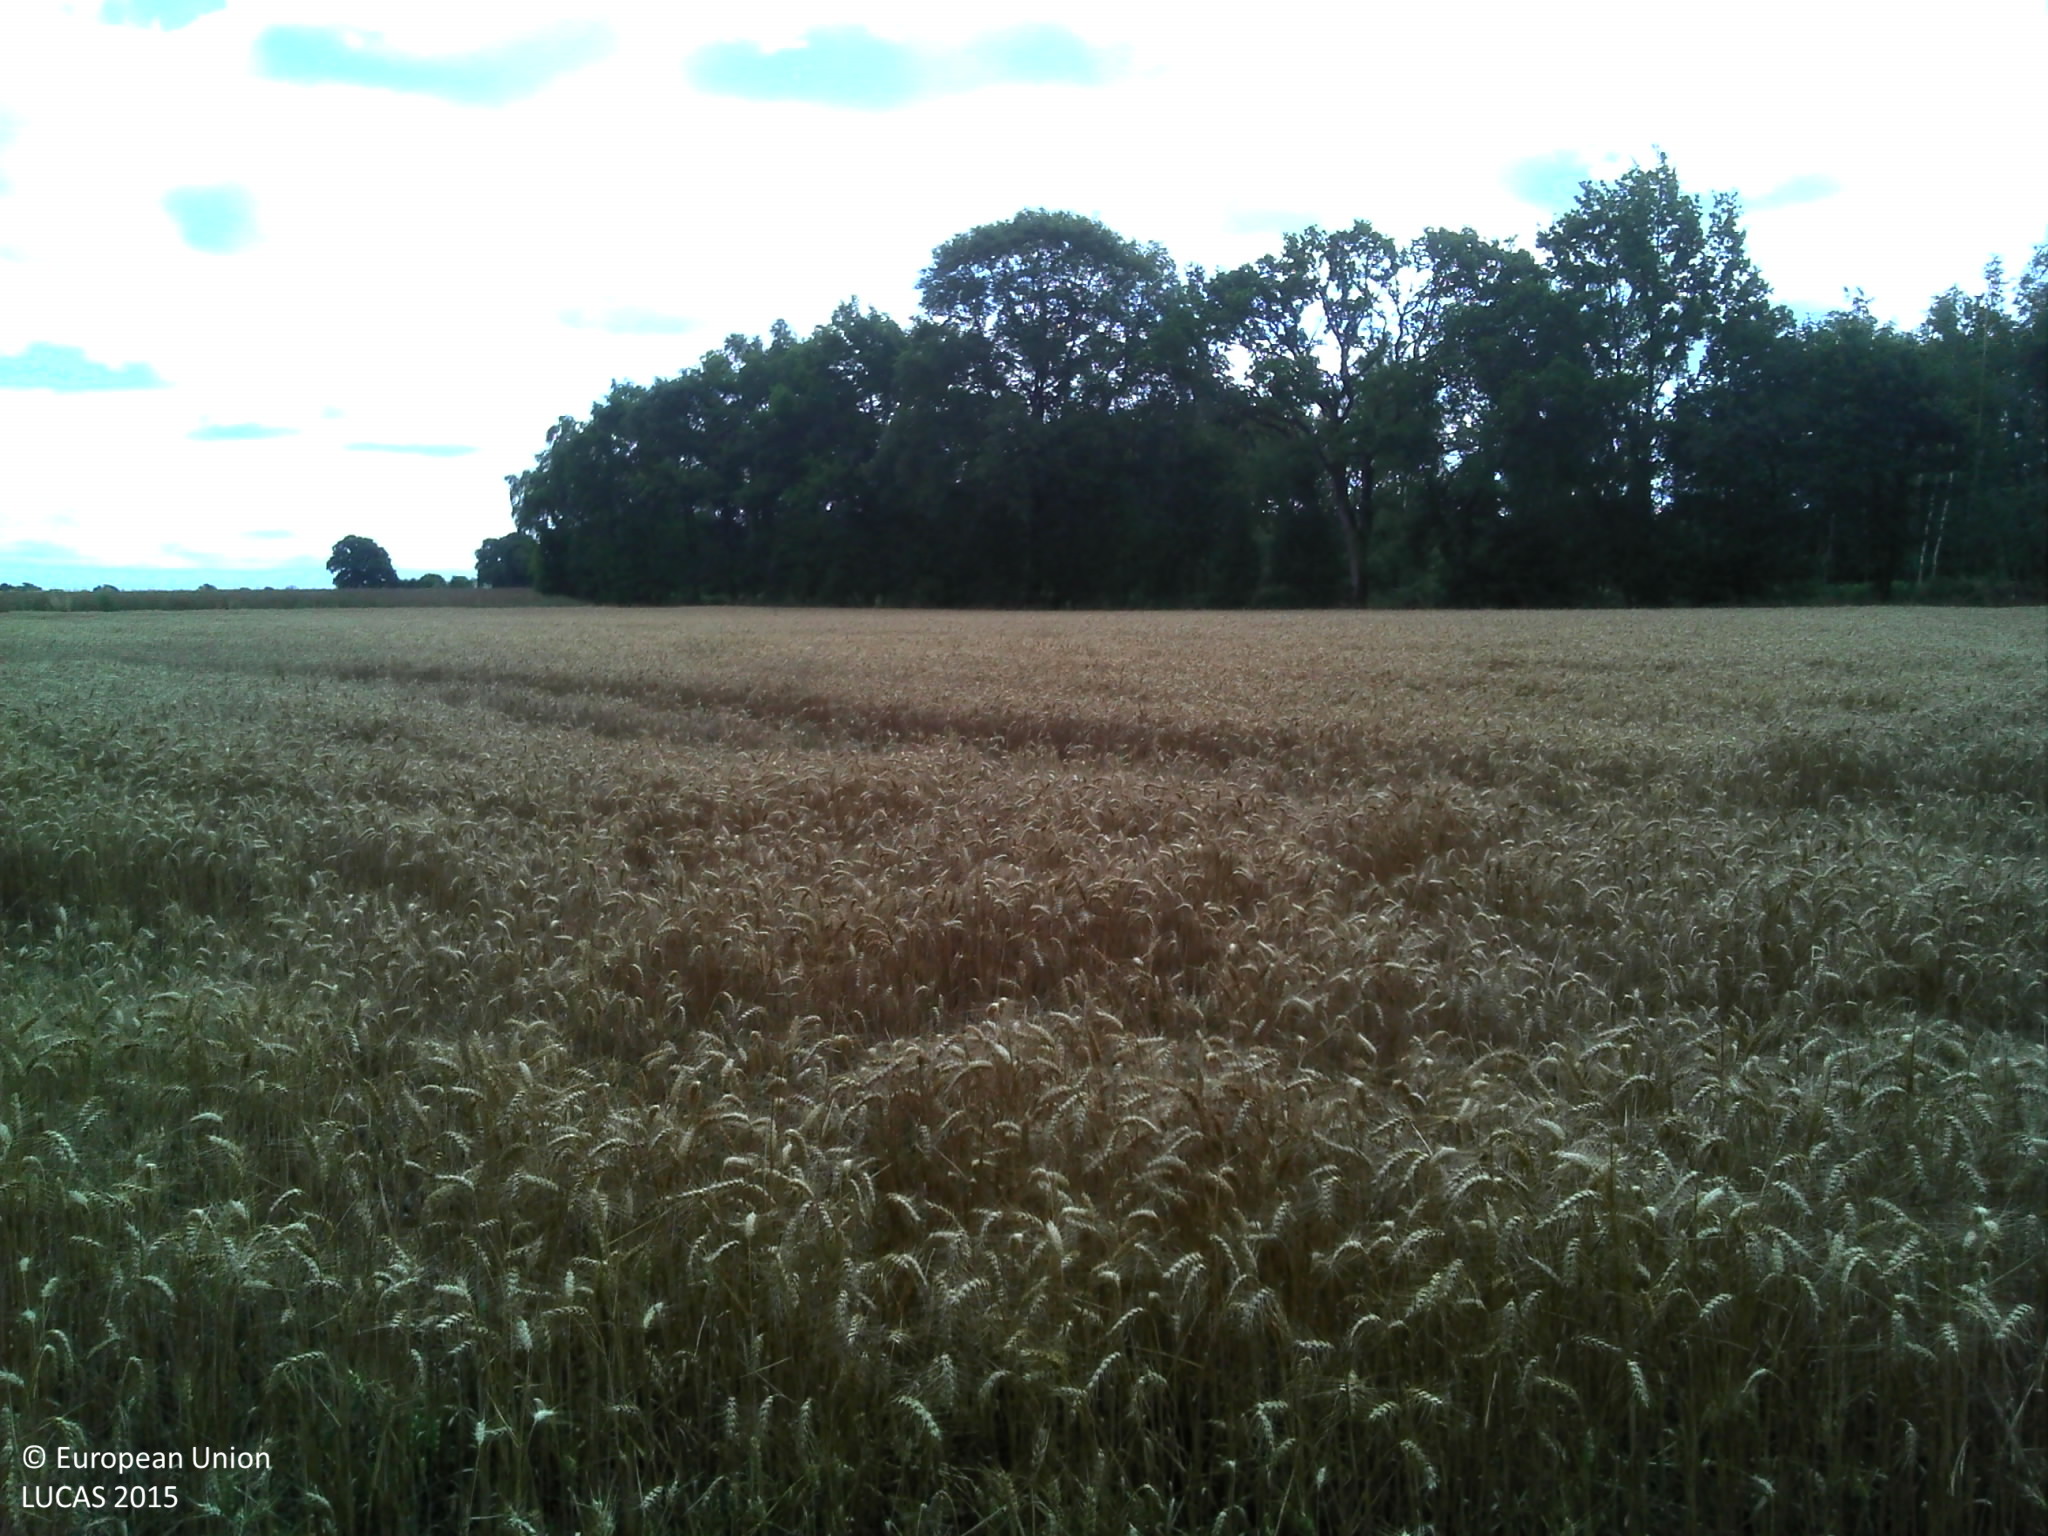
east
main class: Cropland
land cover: Common wheat
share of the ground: > 75 %
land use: Agriculture (excluding fallow land and kitchen gardens)
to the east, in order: Common wheat; Broadleaved woodland; Rape and turnip rape
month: July
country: FR
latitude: 47.6096
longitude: -1.9286
